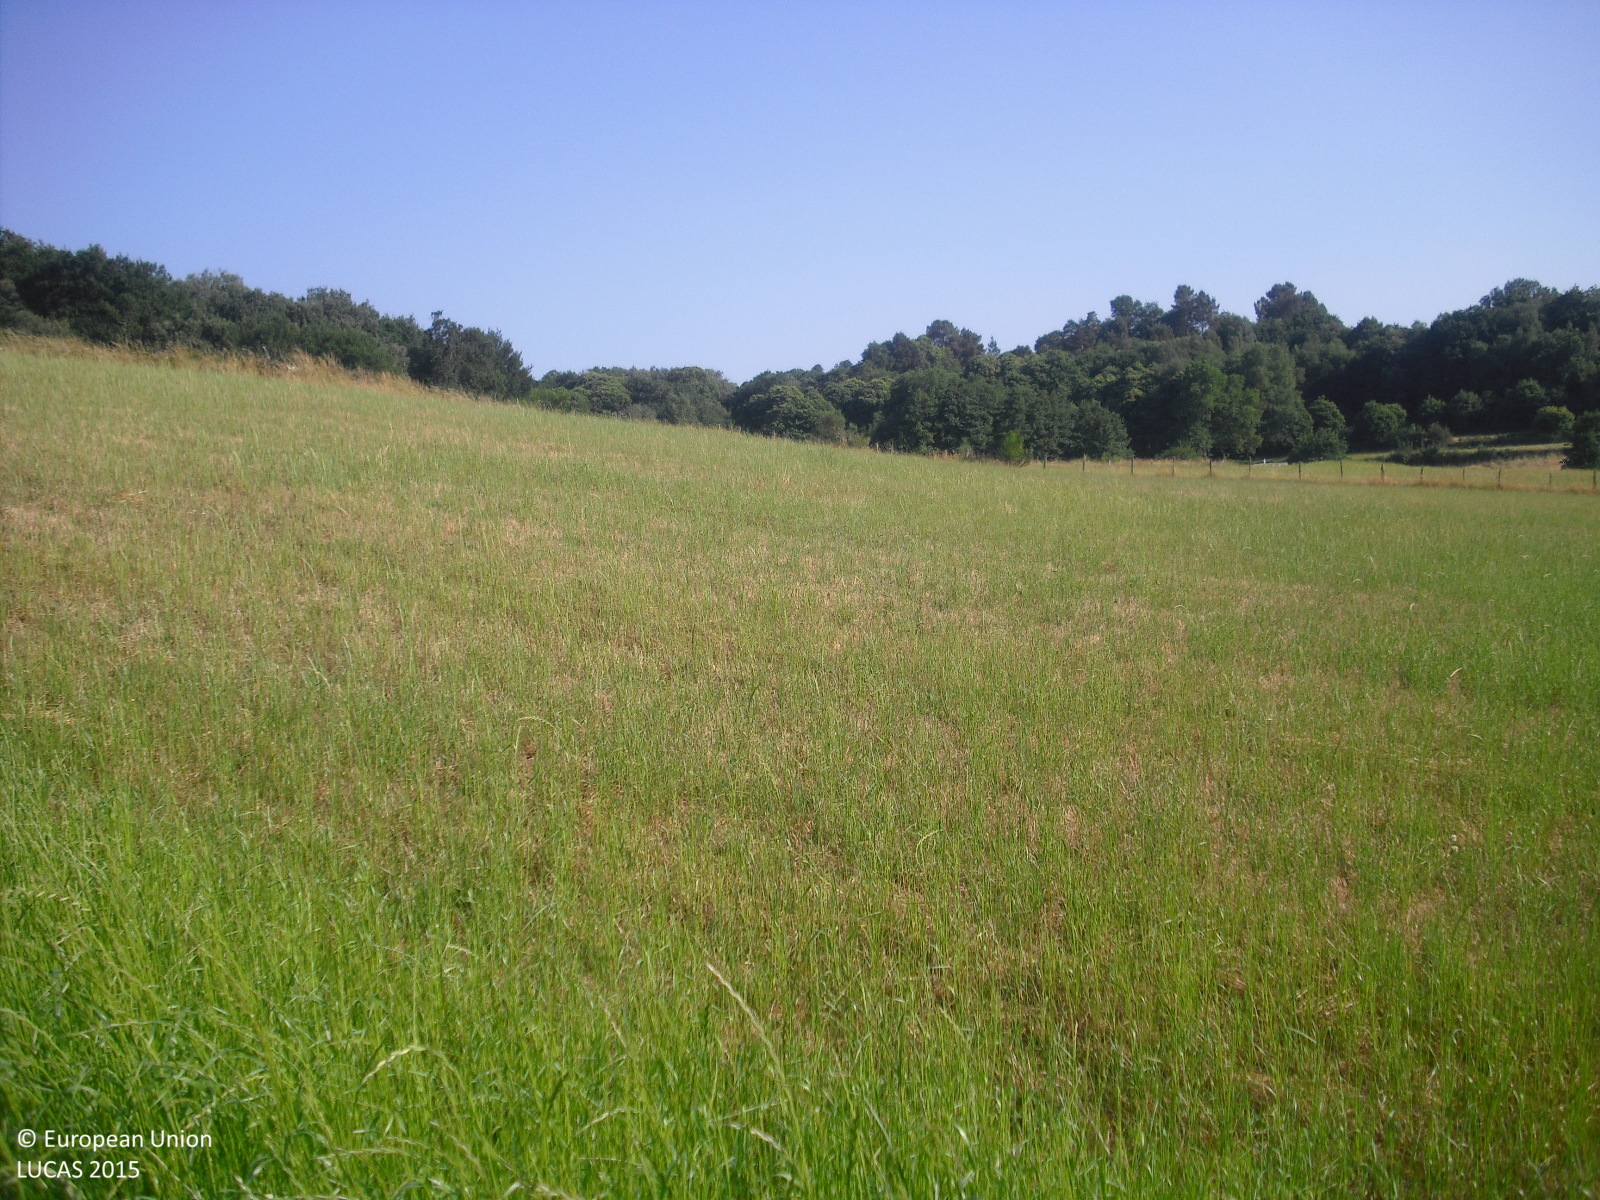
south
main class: Cropland
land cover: Temporary grasslands
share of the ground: > 75 %
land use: Agriculture (excluding fallow land and kitchen gardens)
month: June
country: ES
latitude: 42.5874
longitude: -7.8339
